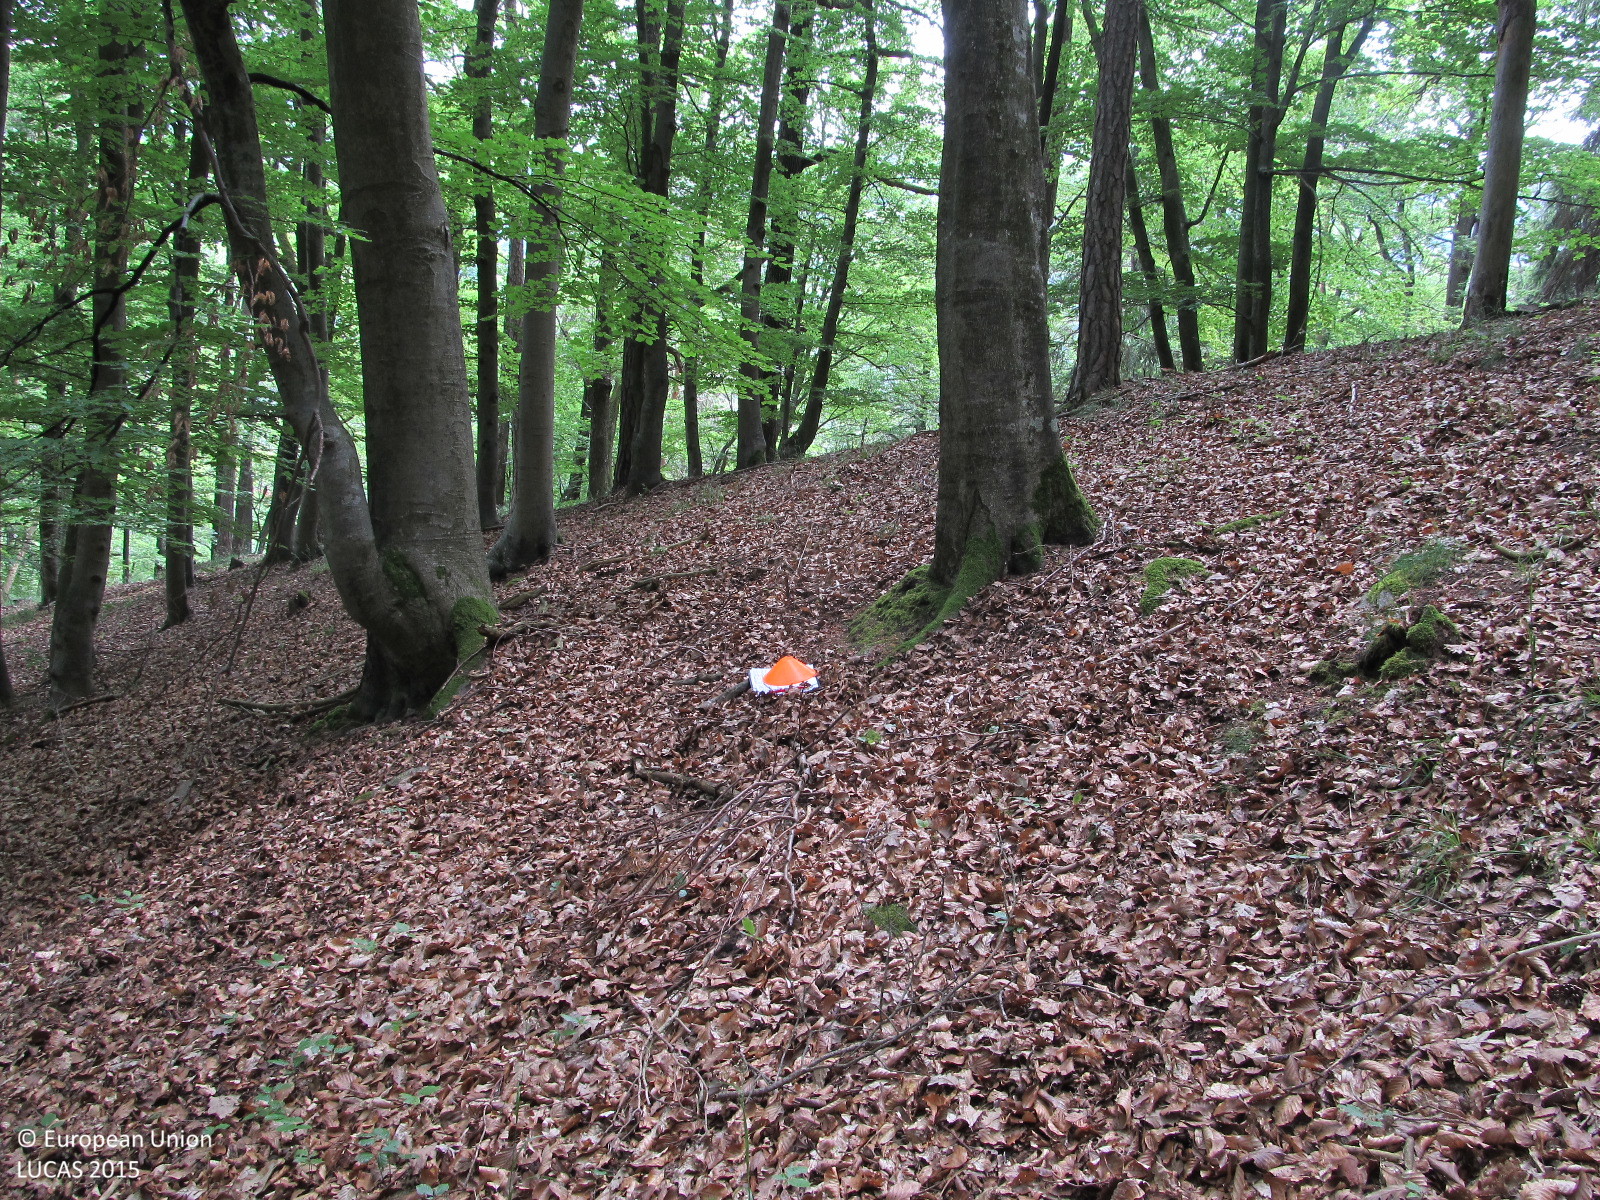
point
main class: Woodland
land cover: Broadleaved woodland
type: beech forest
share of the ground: > 75 %
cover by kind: broadleaved forest trees 60 %, coniferous forest trees 20 %, unconsolidated bare surface 20 %
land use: Forestry
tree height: > 5 m
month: June
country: AT
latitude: 48.4135
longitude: 15.4473
